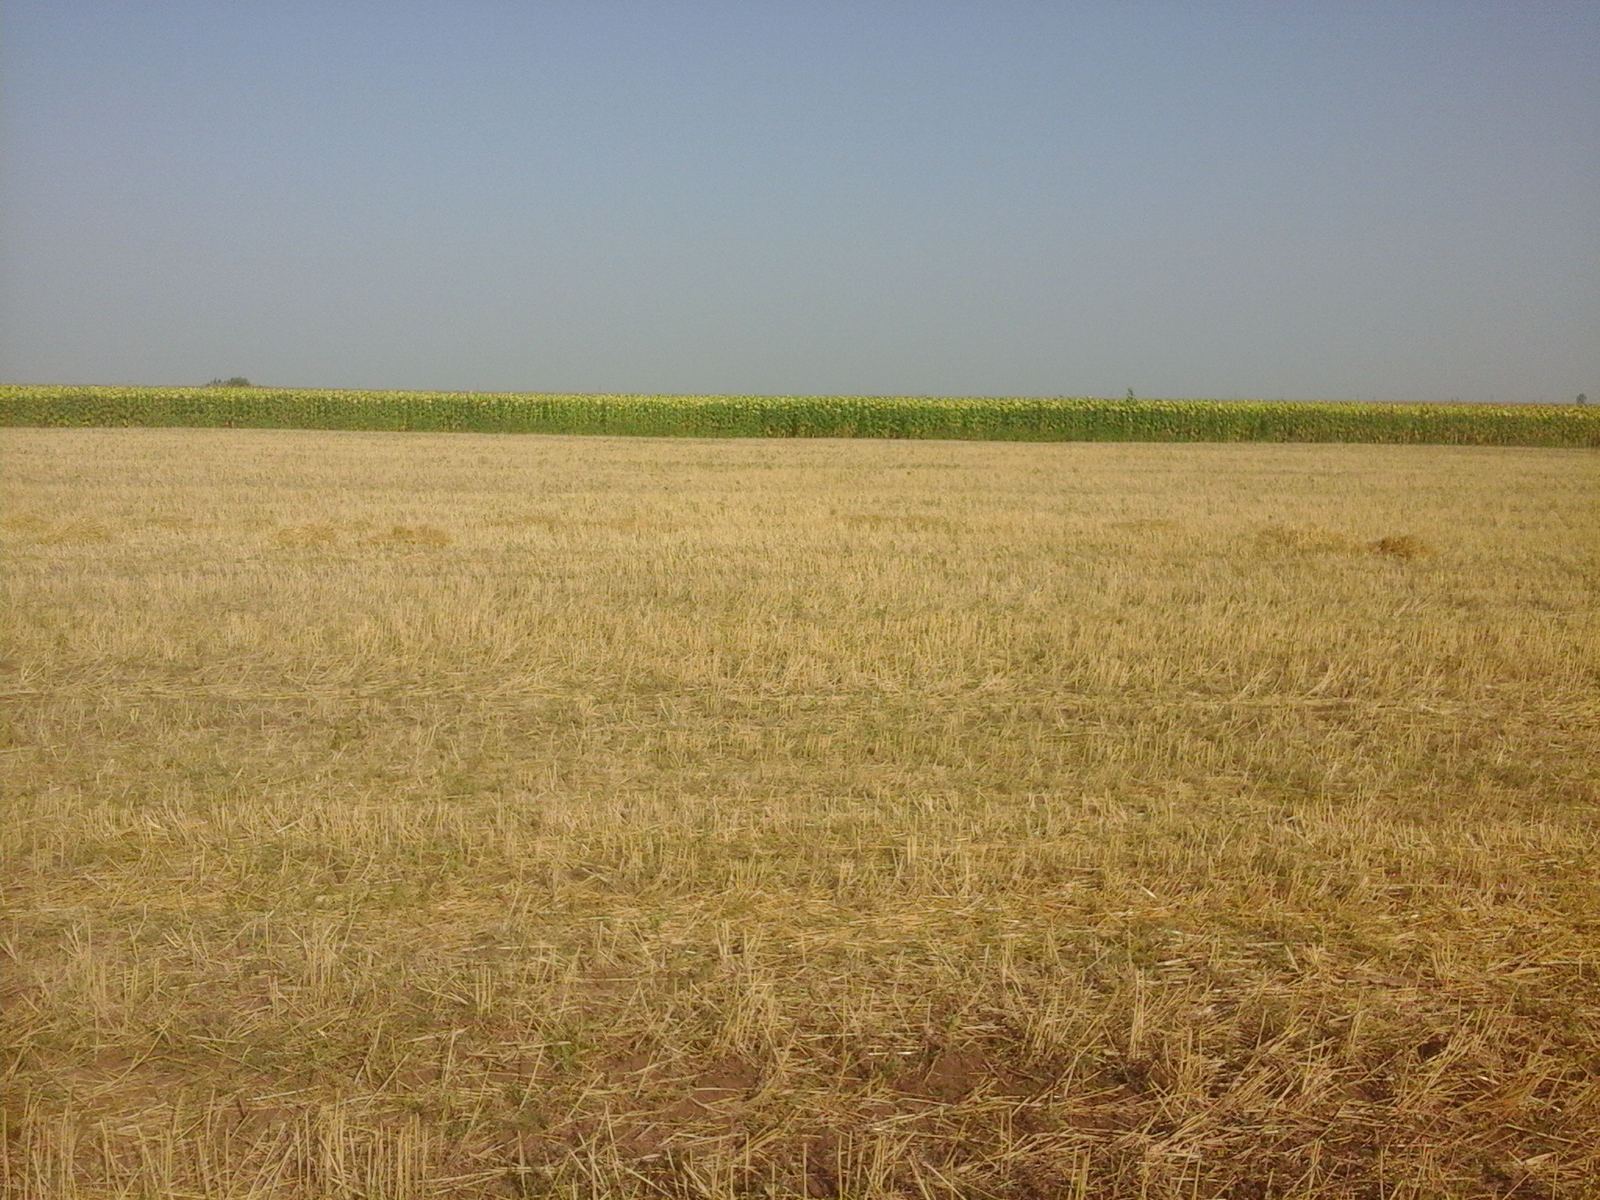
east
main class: Cropland
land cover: Common wheat
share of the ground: > 75 %
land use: Agriculture (excluding fallow land and kitchen gardens)
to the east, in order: Grass margins; Common wheat; Sunflower; Maize; Lucerne
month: August
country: RO
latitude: 45.0149
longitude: 27.5467
